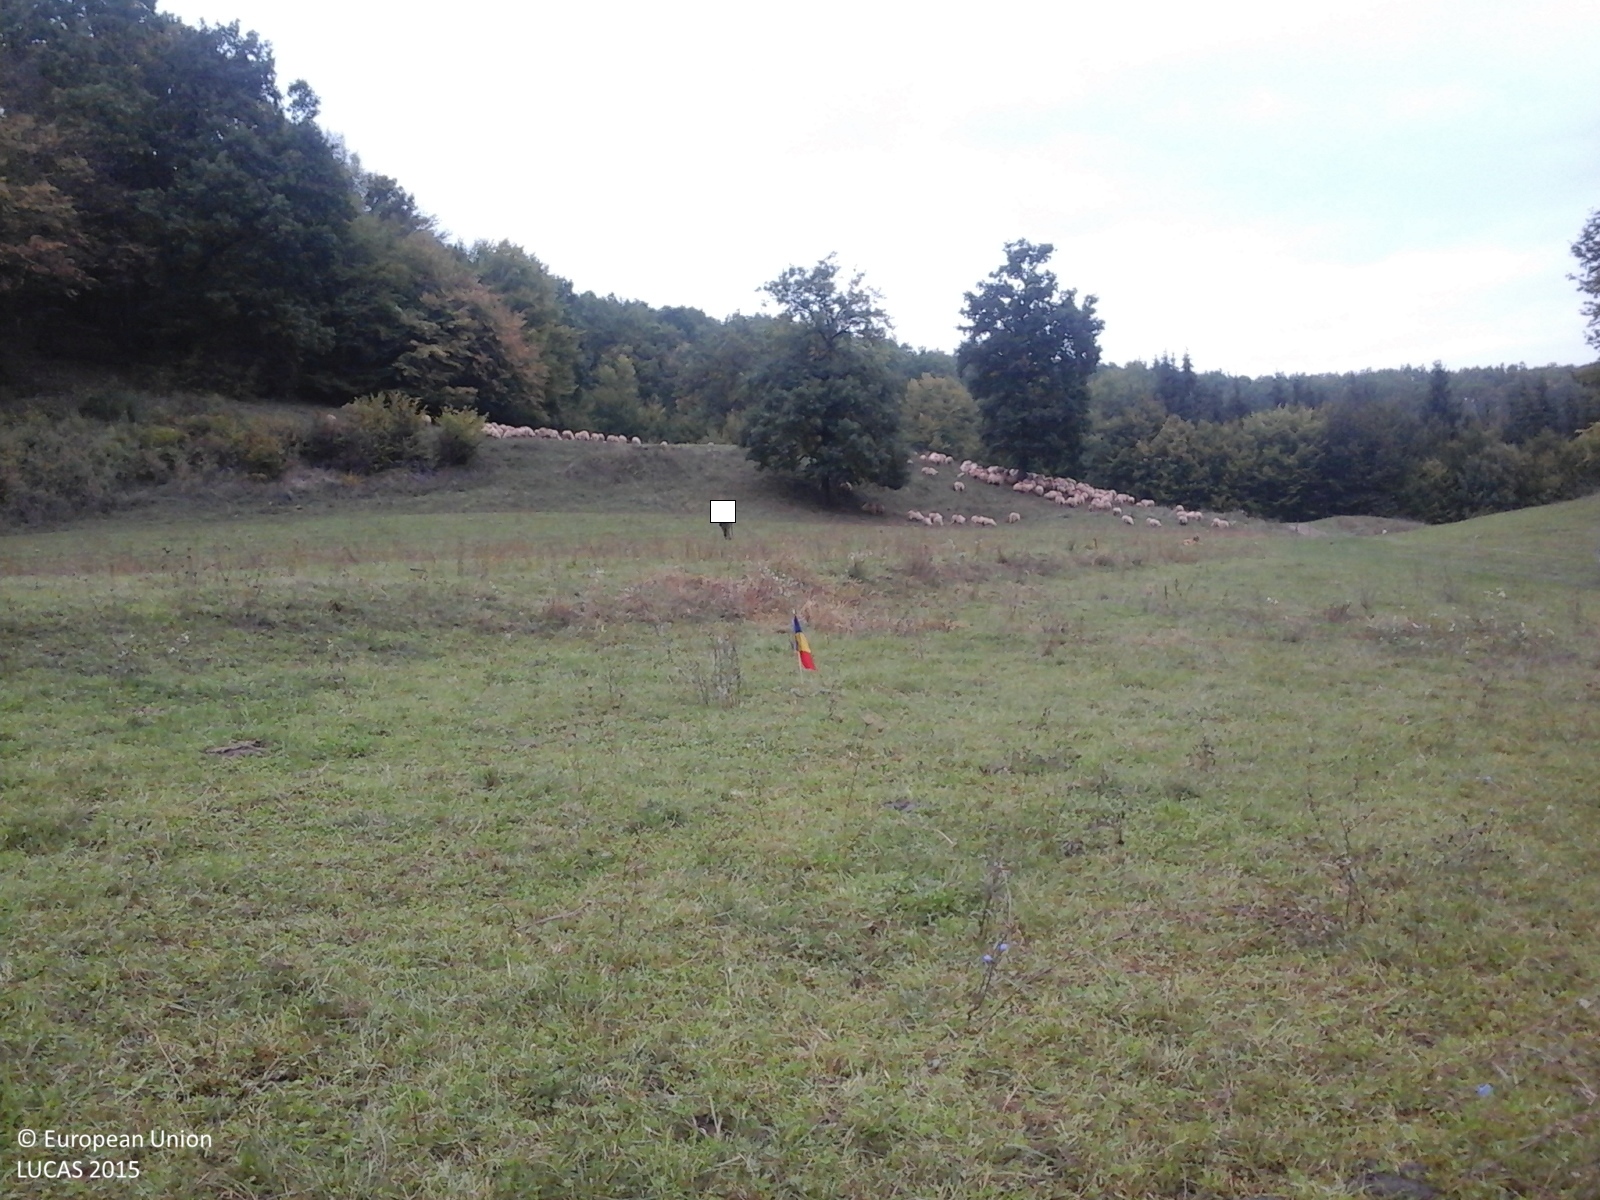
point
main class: Grassland
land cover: Grassland without tree/shrub cover
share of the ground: > 75 %
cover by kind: herbaceous plants 100 %
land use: Agriculture (excluding fallow land and kitchen gardens)
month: October
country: RO
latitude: 46.8448
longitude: 24.8490
